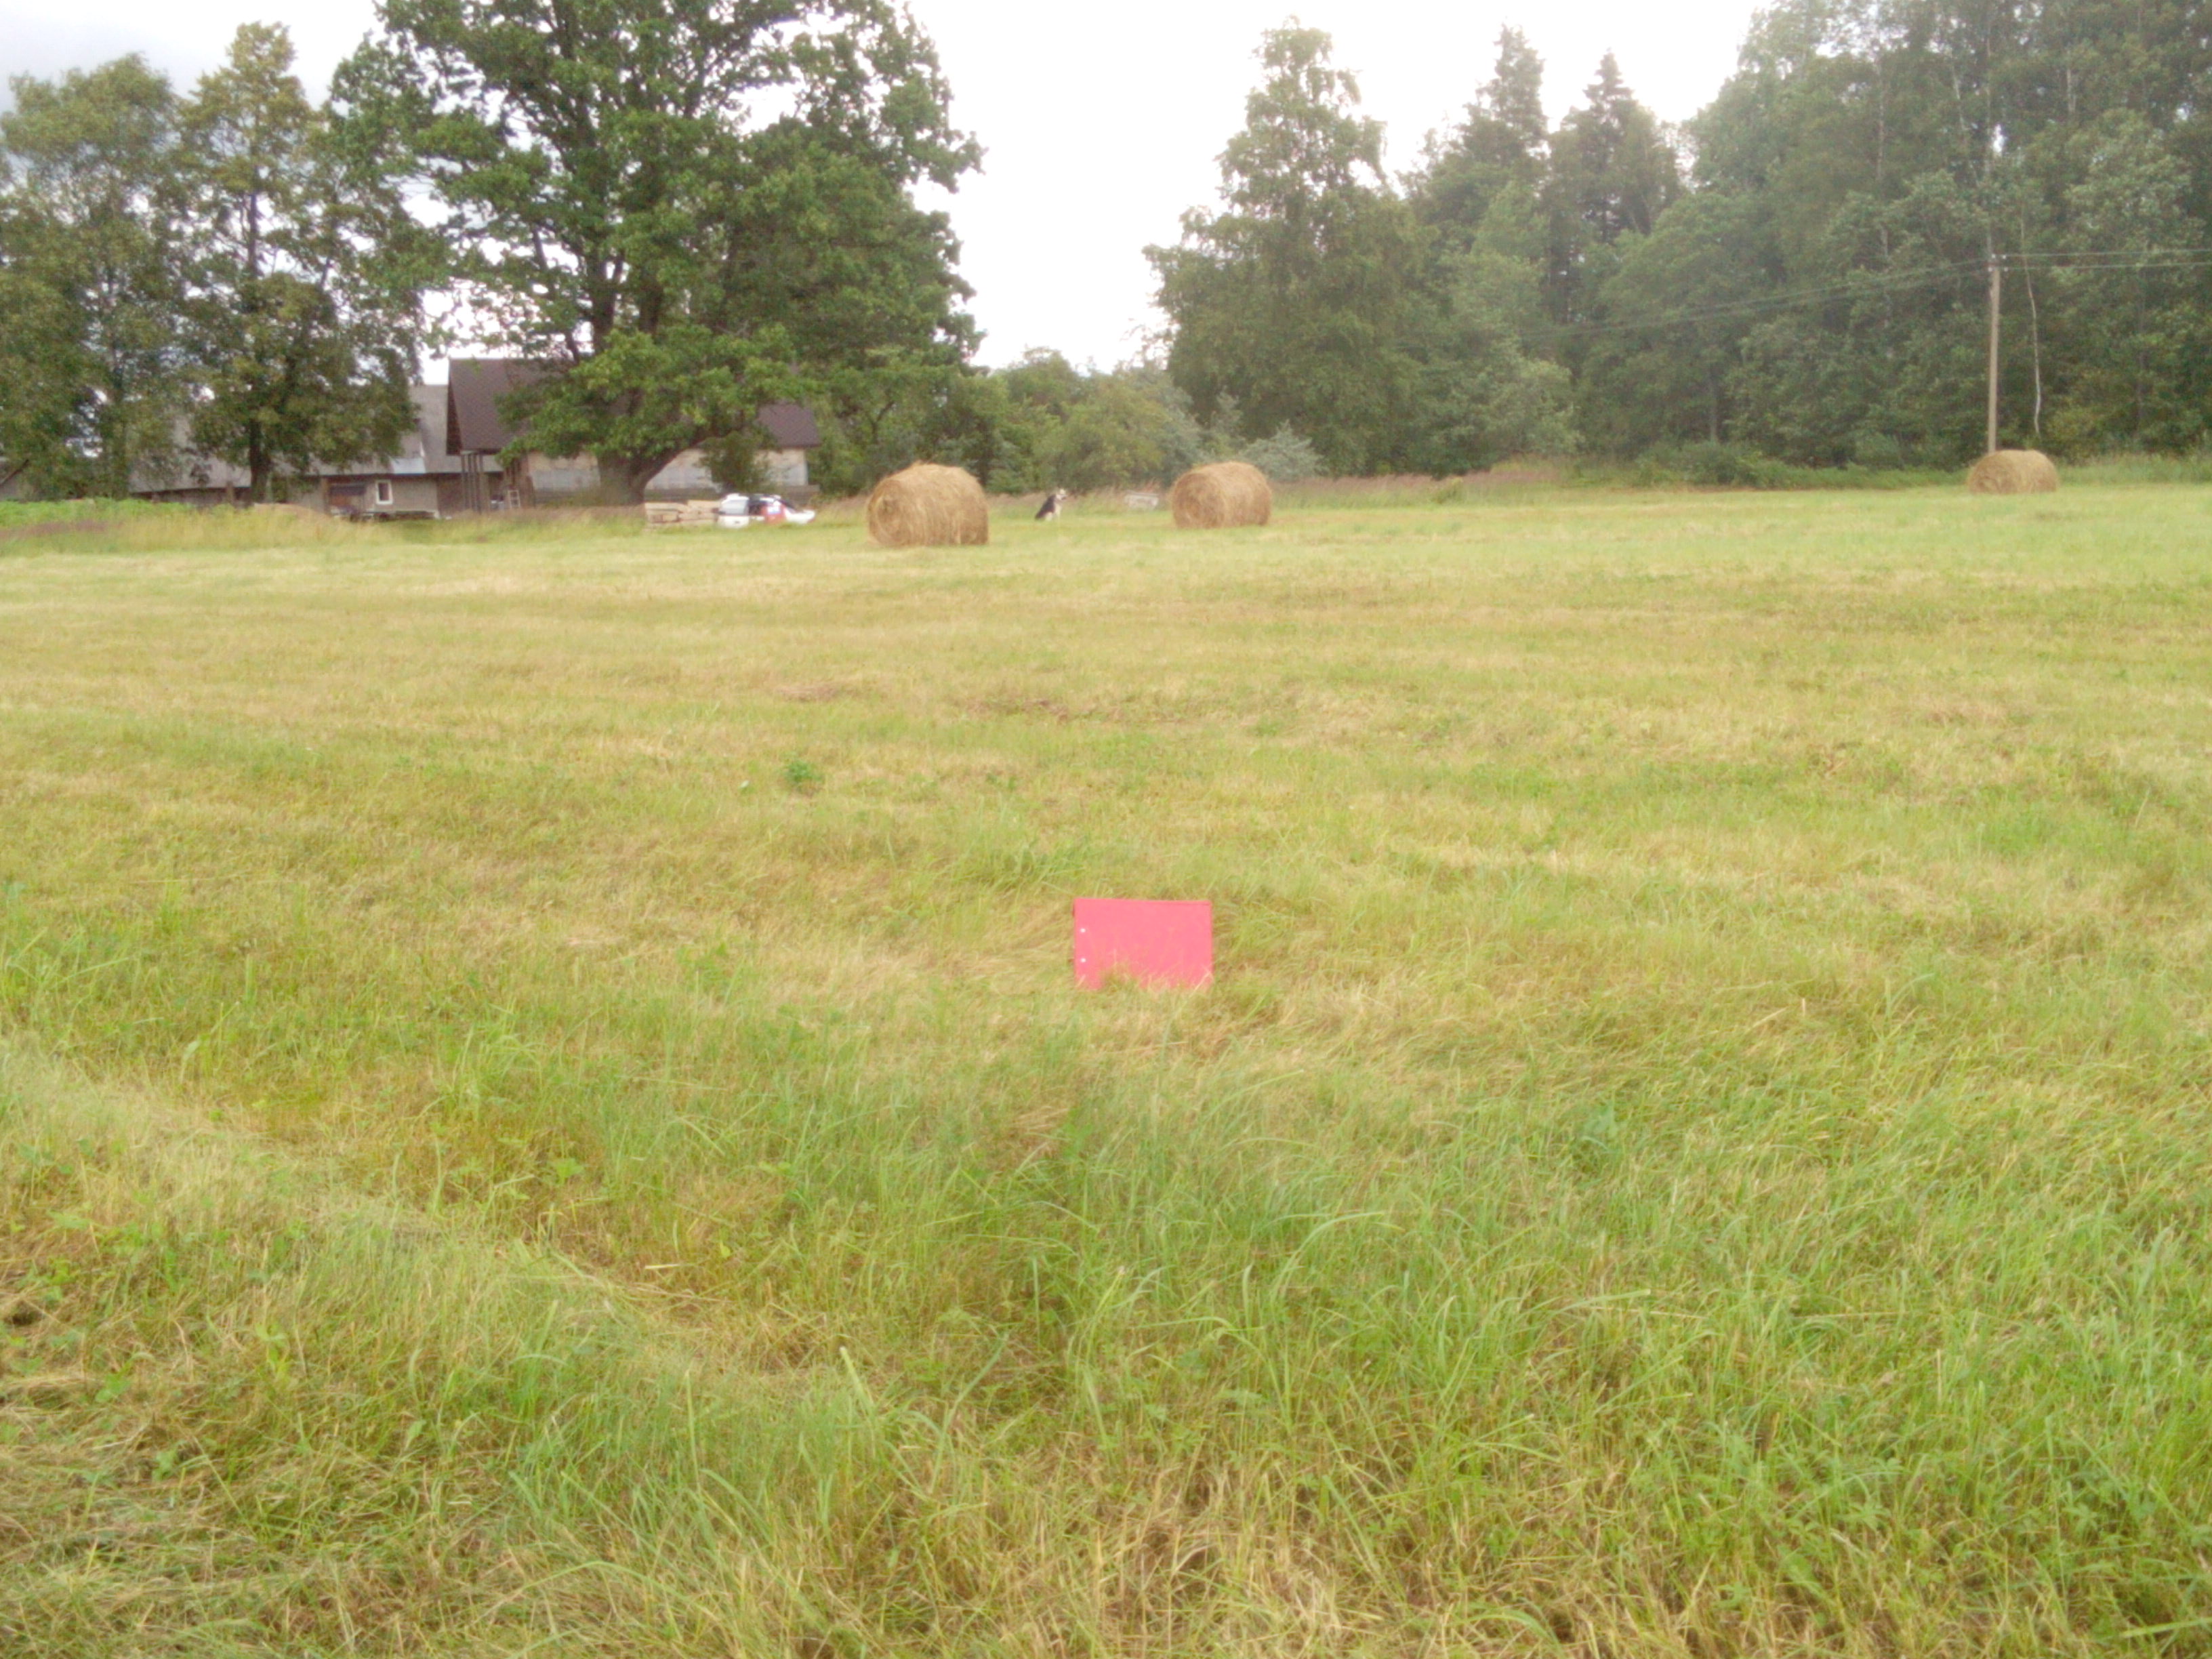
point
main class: Grassland
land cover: Grassland without tree/shrub cover
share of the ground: > 75 %
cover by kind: herbaceous plants 100 %
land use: Agriculture (excluding fallow land and kitchen gardens)
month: July
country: LV
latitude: 56.9657
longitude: 22.0383
